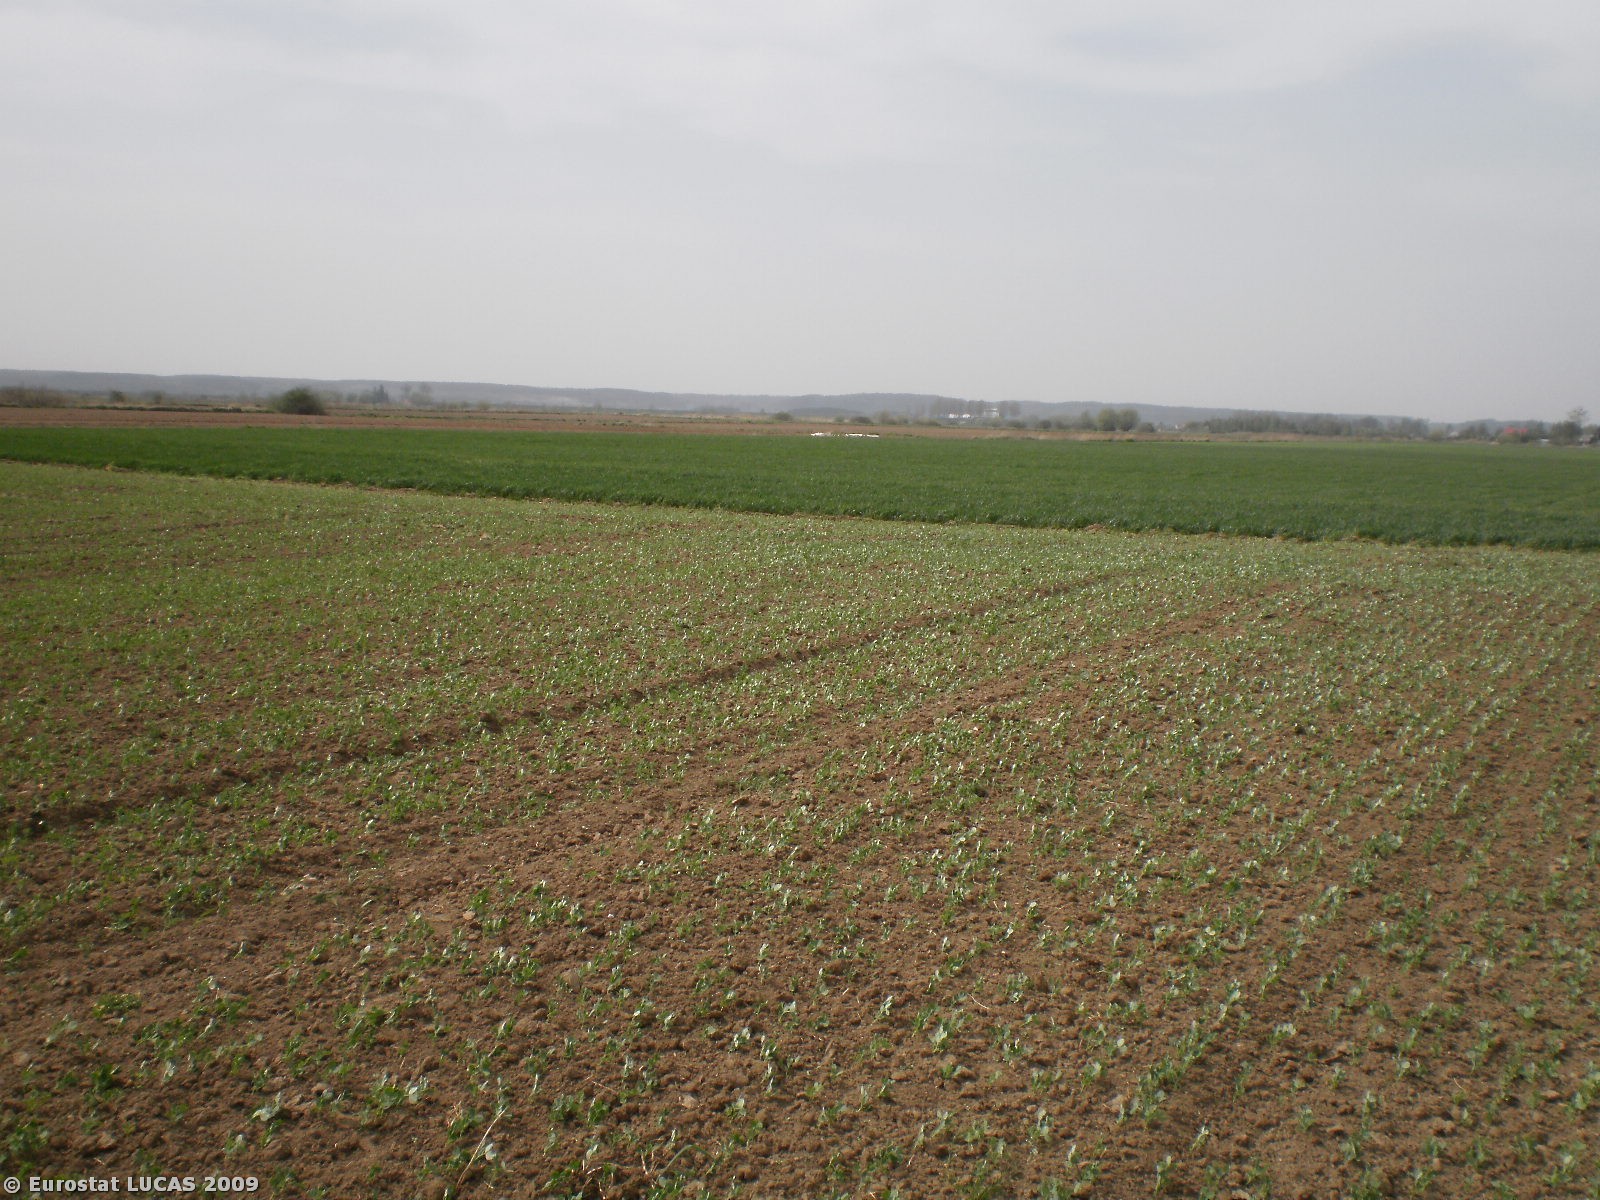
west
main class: Cropland
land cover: Dry pulses
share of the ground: 10 - 25 %
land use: Agriculture (excluding fallow land and kitchen gardens)
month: April
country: PL
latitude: 53.7437
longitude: 18.8912
